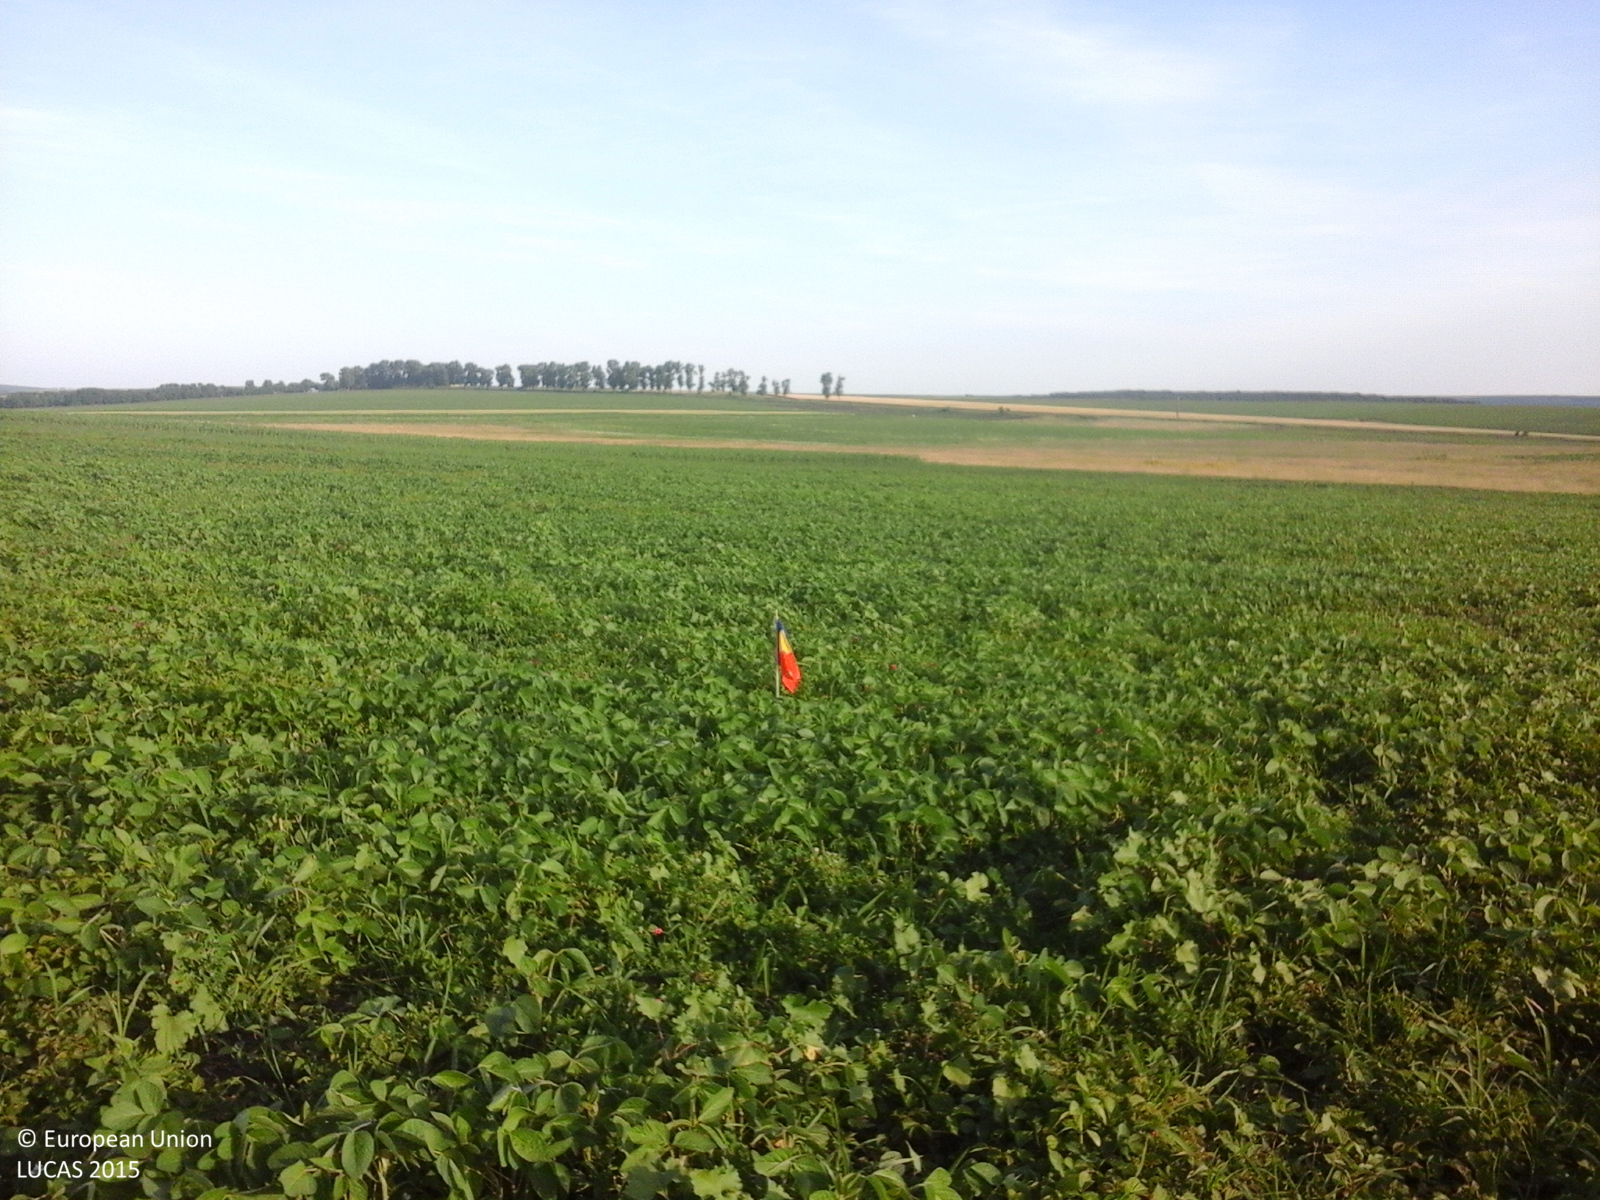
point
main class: Cropland
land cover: Soya
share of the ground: > 75 %
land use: Agriculture (excluding fallow land and kitchen gardens)
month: June
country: RO
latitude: 48.1033
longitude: 26.7660
